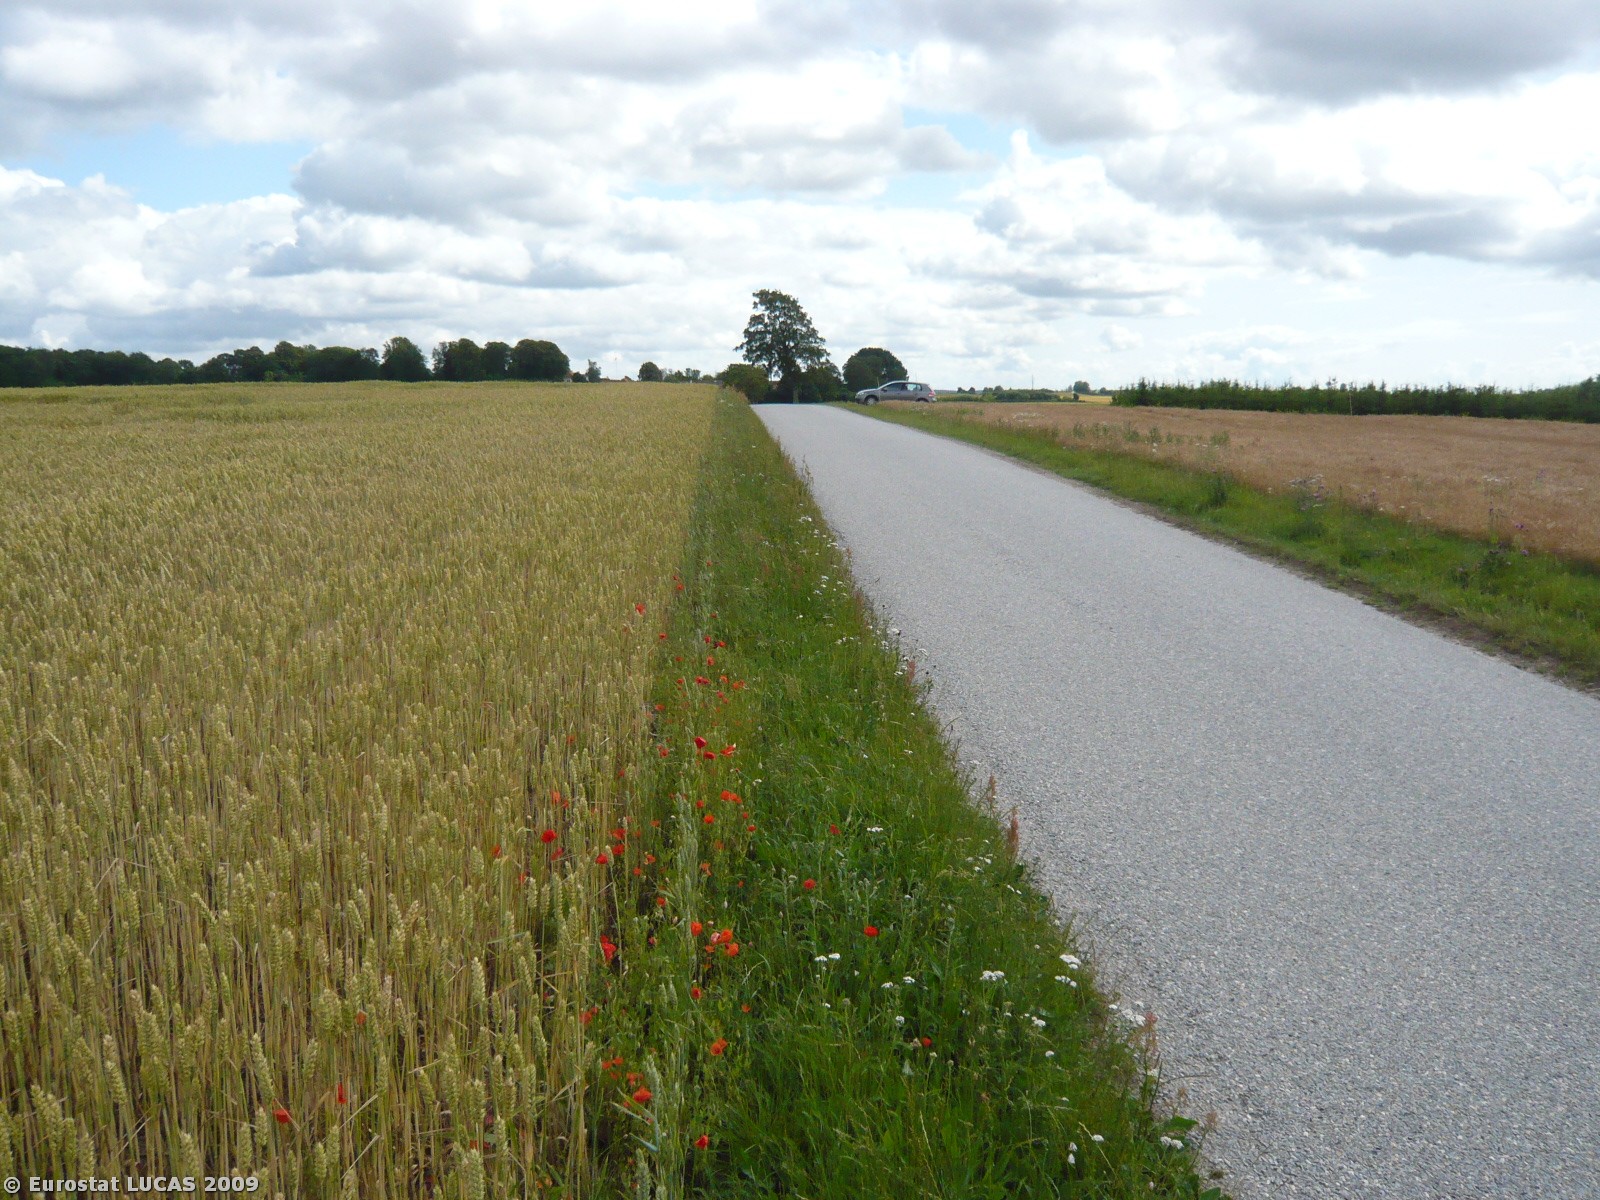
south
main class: Cropland
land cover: Common wheat
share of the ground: > 75 %
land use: Agriculture (excluding fallow land and kitchen gardens)
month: July
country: DK
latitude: 55.4965
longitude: 11.4392
